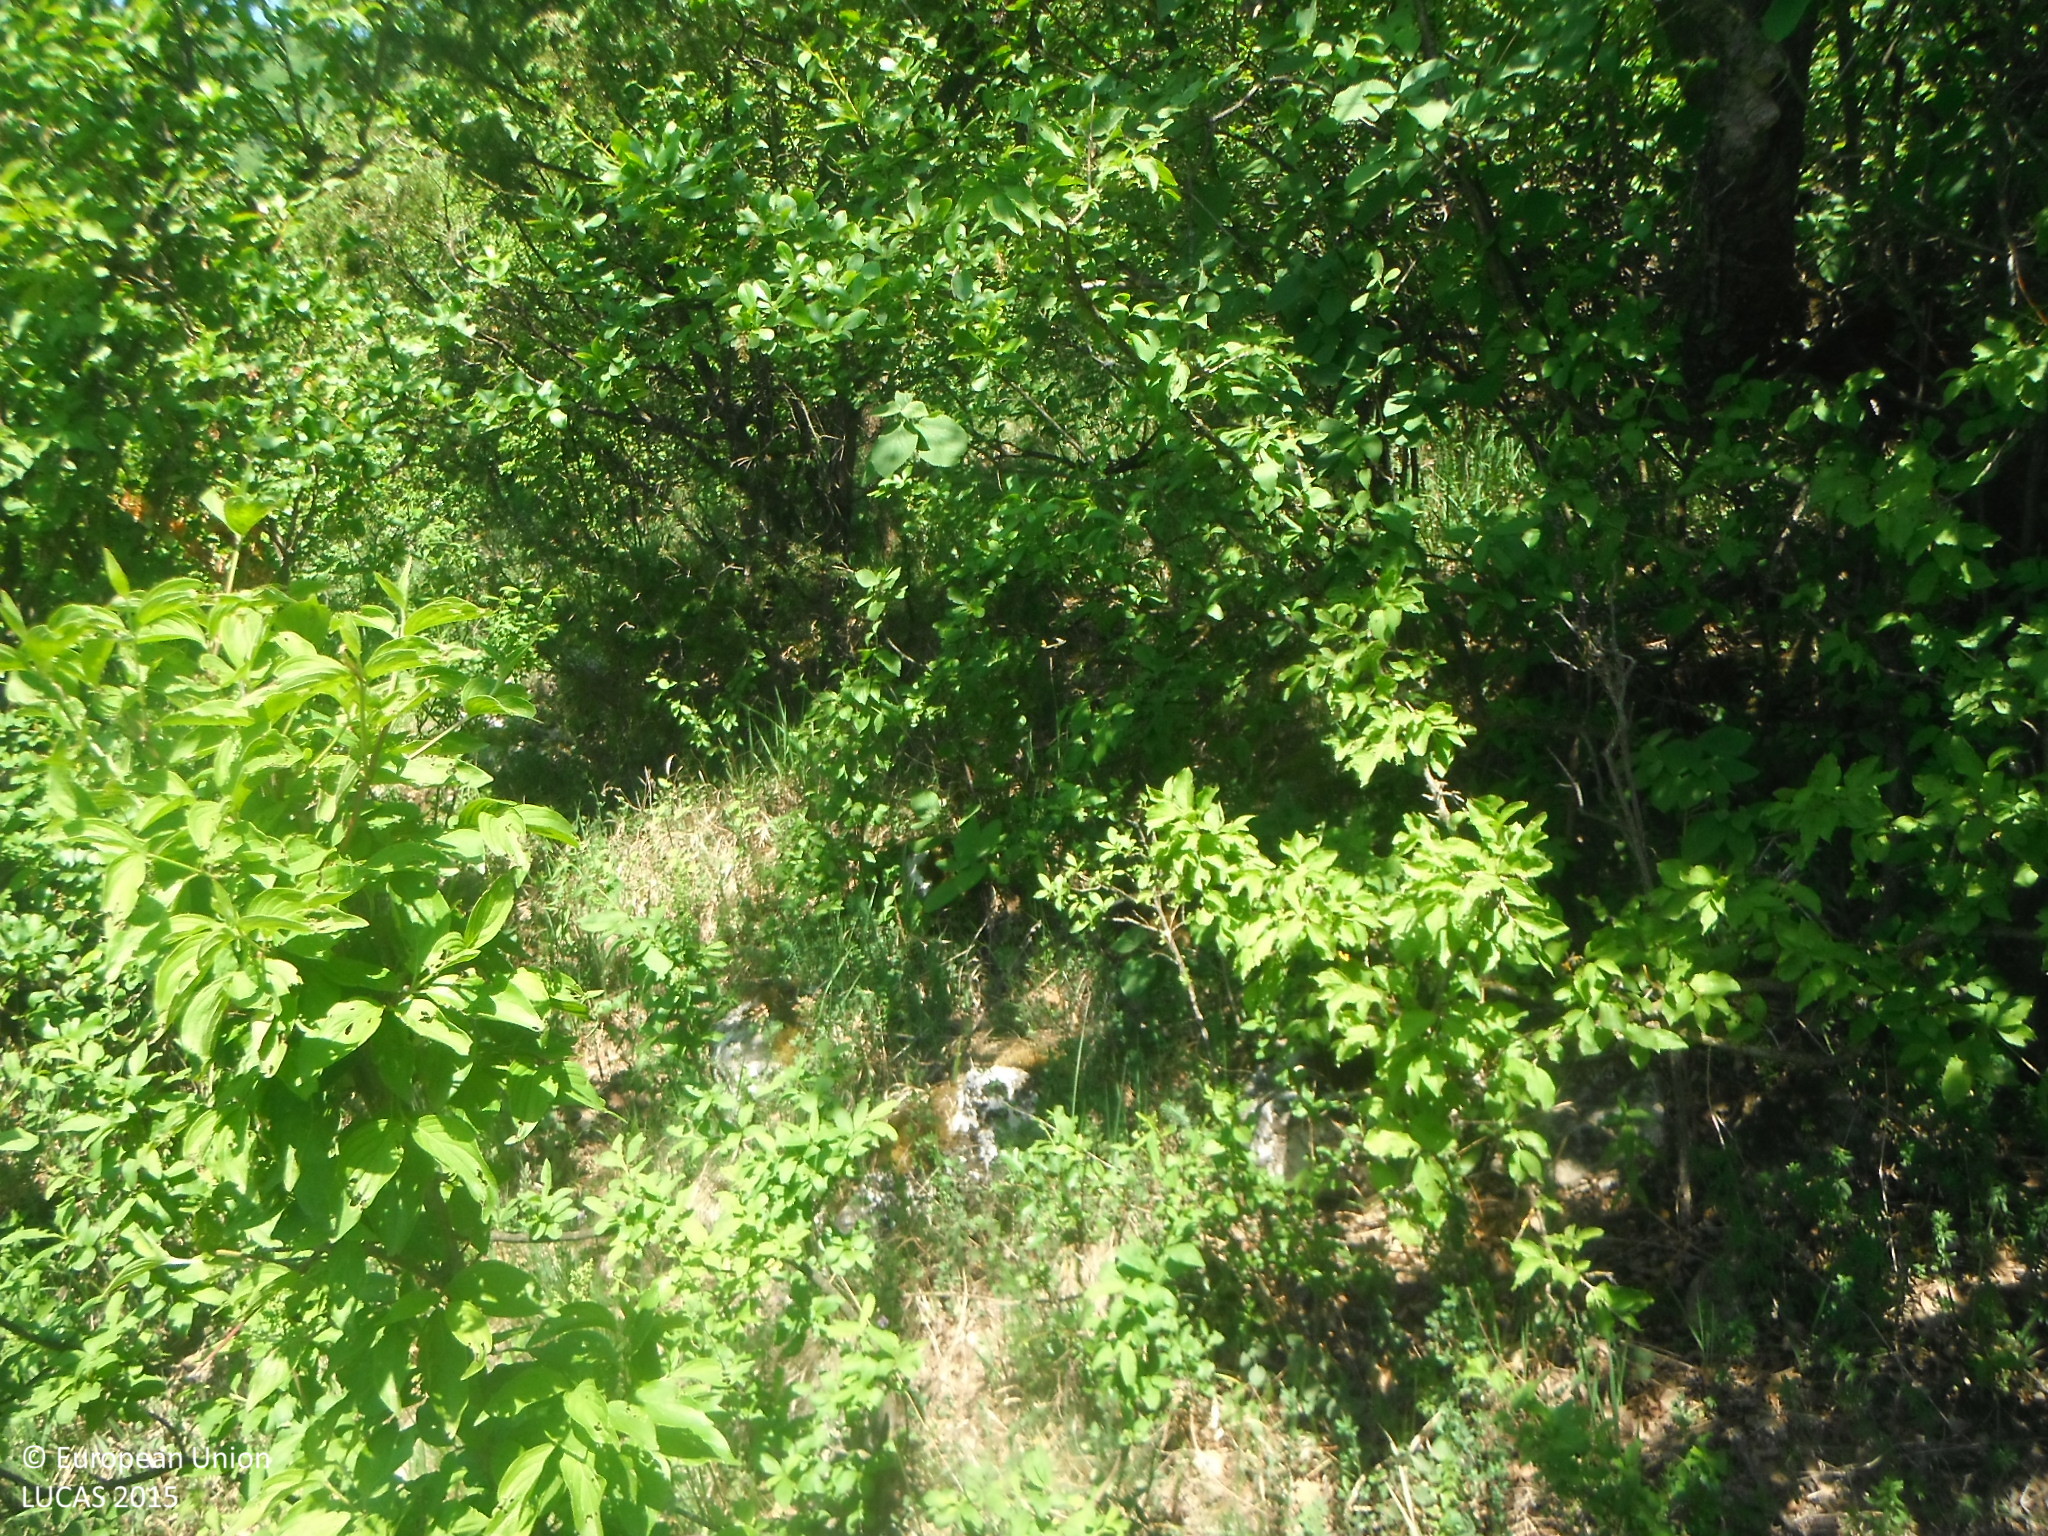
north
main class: Woodland
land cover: Broadleaved woodland
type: mesophytic deciduous forest
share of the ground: 10 - 25 %
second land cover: Shrubland without tree cover
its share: 50 - 75 %
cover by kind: shrubs 60 %, broadleaved forest trees 25 %, herbaceous plants 15 %
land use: Semi-natural and natural areas not in use
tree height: > 5 m
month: May
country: SK
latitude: 48.6247
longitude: 20.9071
